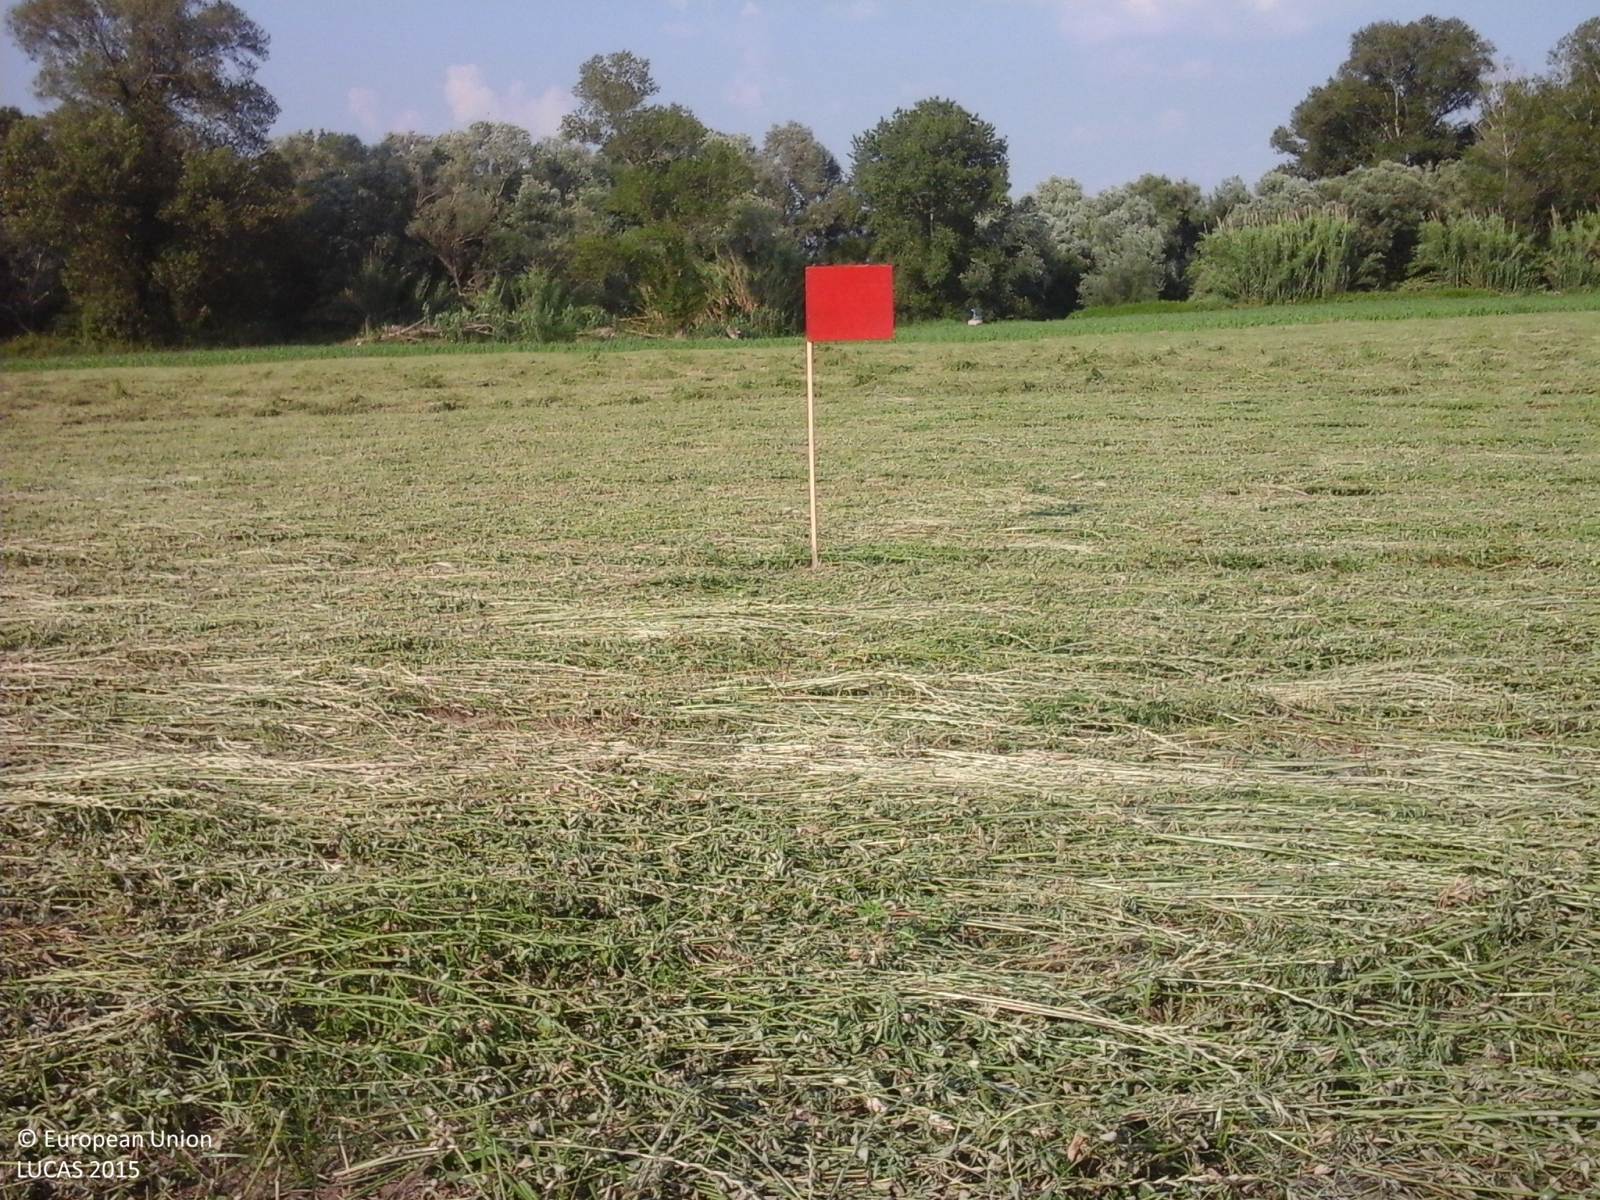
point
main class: Cropland
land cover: Other leguminous and mixtures for fodder
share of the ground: > 75 %
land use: Agriculture (excluding fallow land and kitchen gardens)
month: June
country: IT
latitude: 40.5508
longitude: 15.1154
